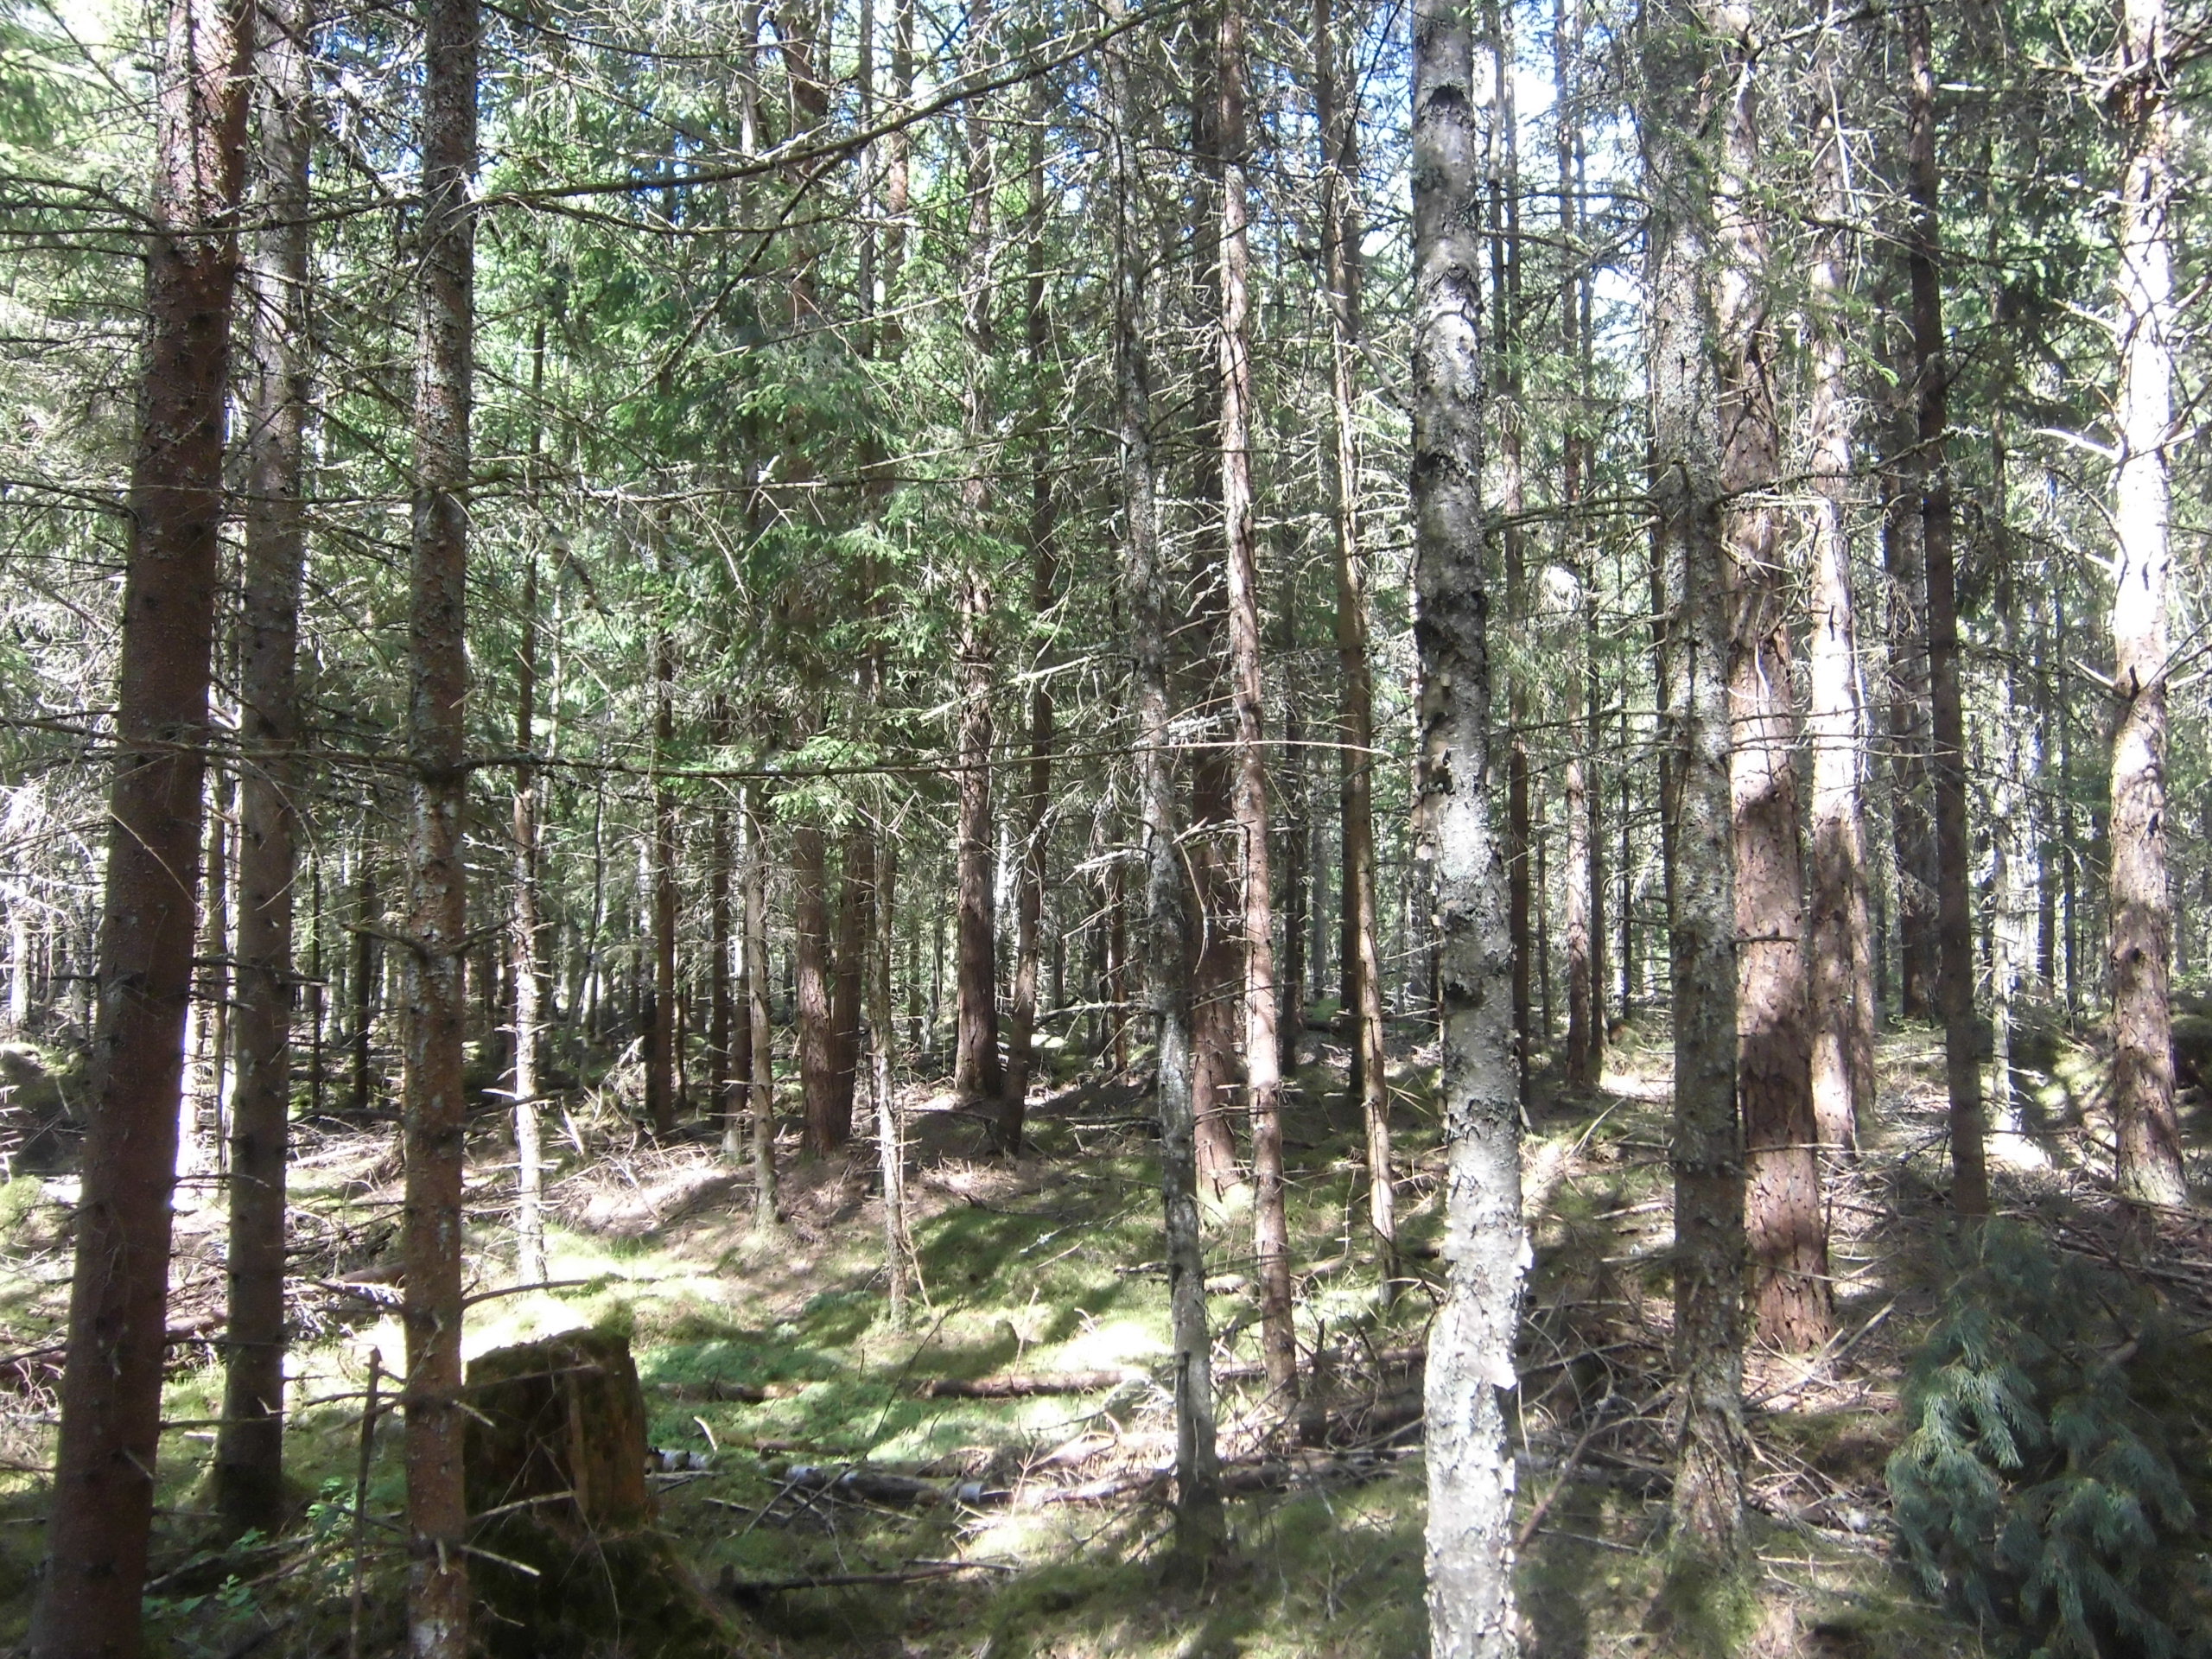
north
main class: Woodland
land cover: Pine dominated coniferous woodland
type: boreal forest
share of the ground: 50 - 75 %
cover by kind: coniferous forest trees 60 %, lichens and mosses 25 %, shrubs 10 %, herbaceous plants 5 %
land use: Forestry
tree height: > 5 m
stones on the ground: < 10 %
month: July
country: SE
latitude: 57.2915
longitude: 15.1571
